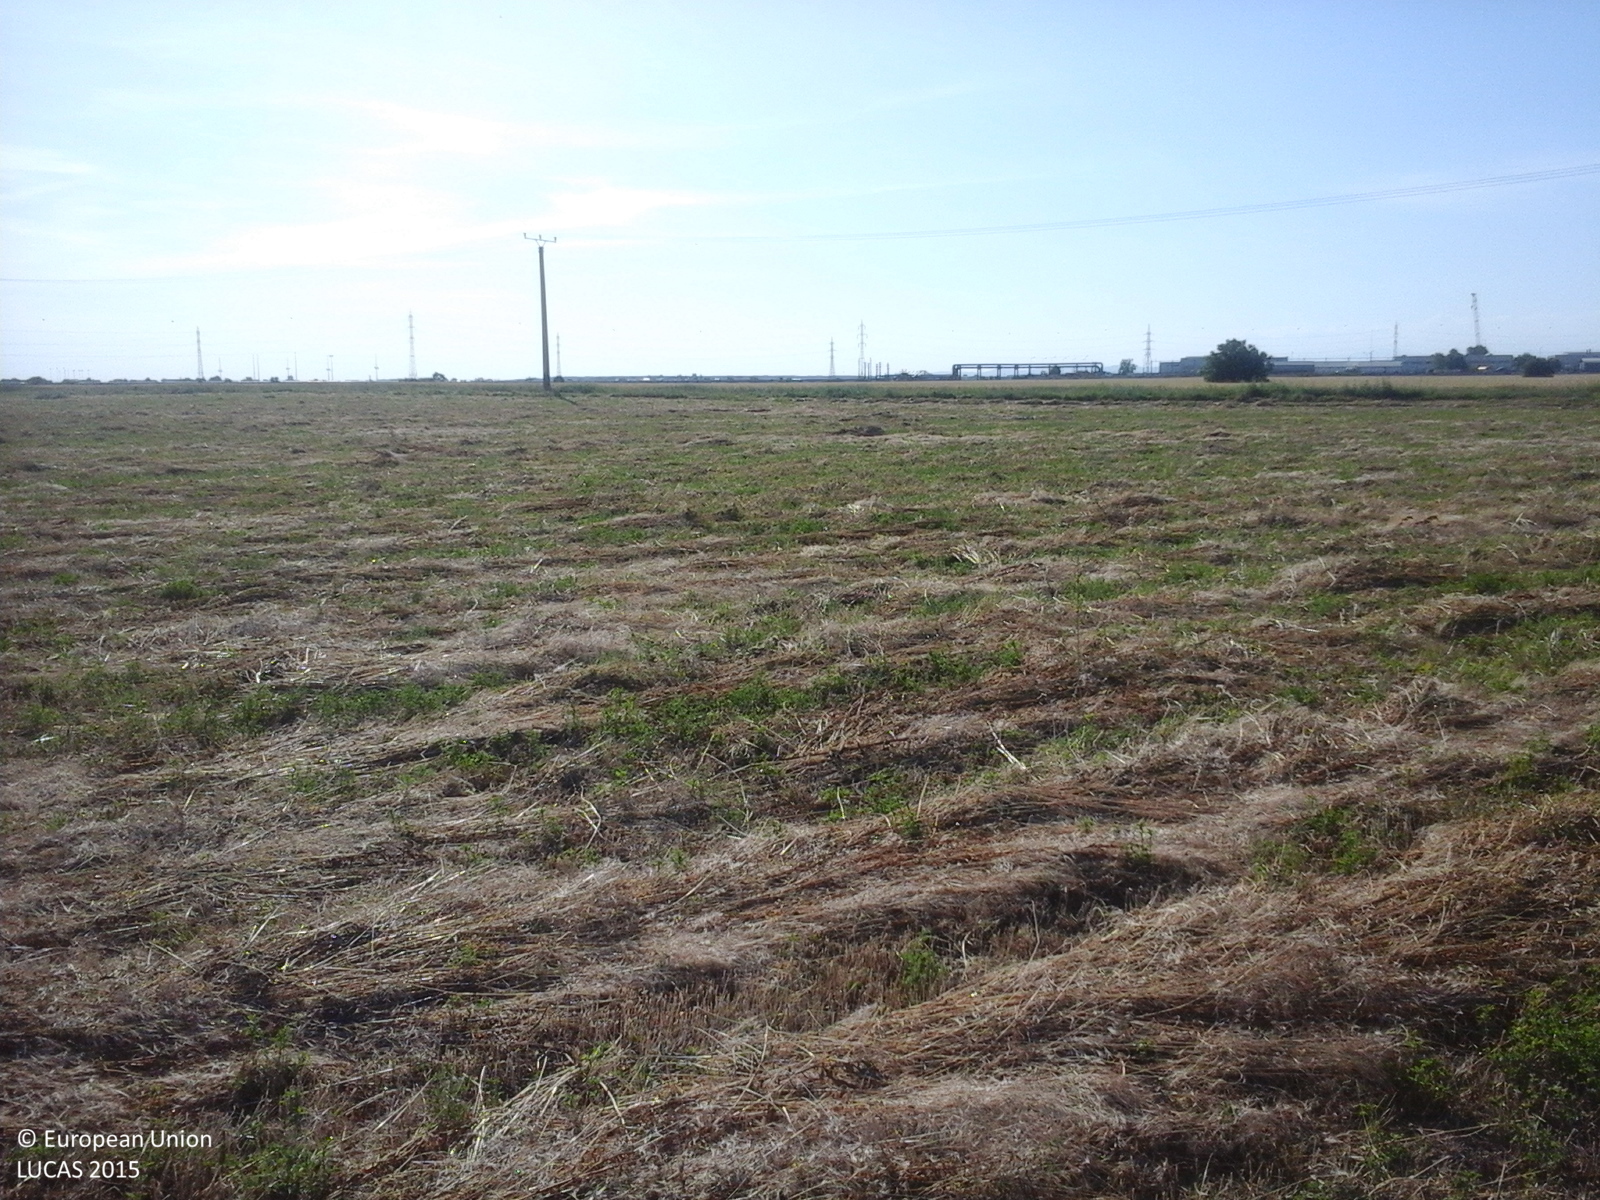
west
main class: Cropland
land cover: Lucerne
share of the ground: > 75 %
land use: Agriculture (excluding fallow land and kitchen gardens)
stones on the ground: < 10 %
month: June
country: RO
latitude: 44.9159
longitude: 26.0050
